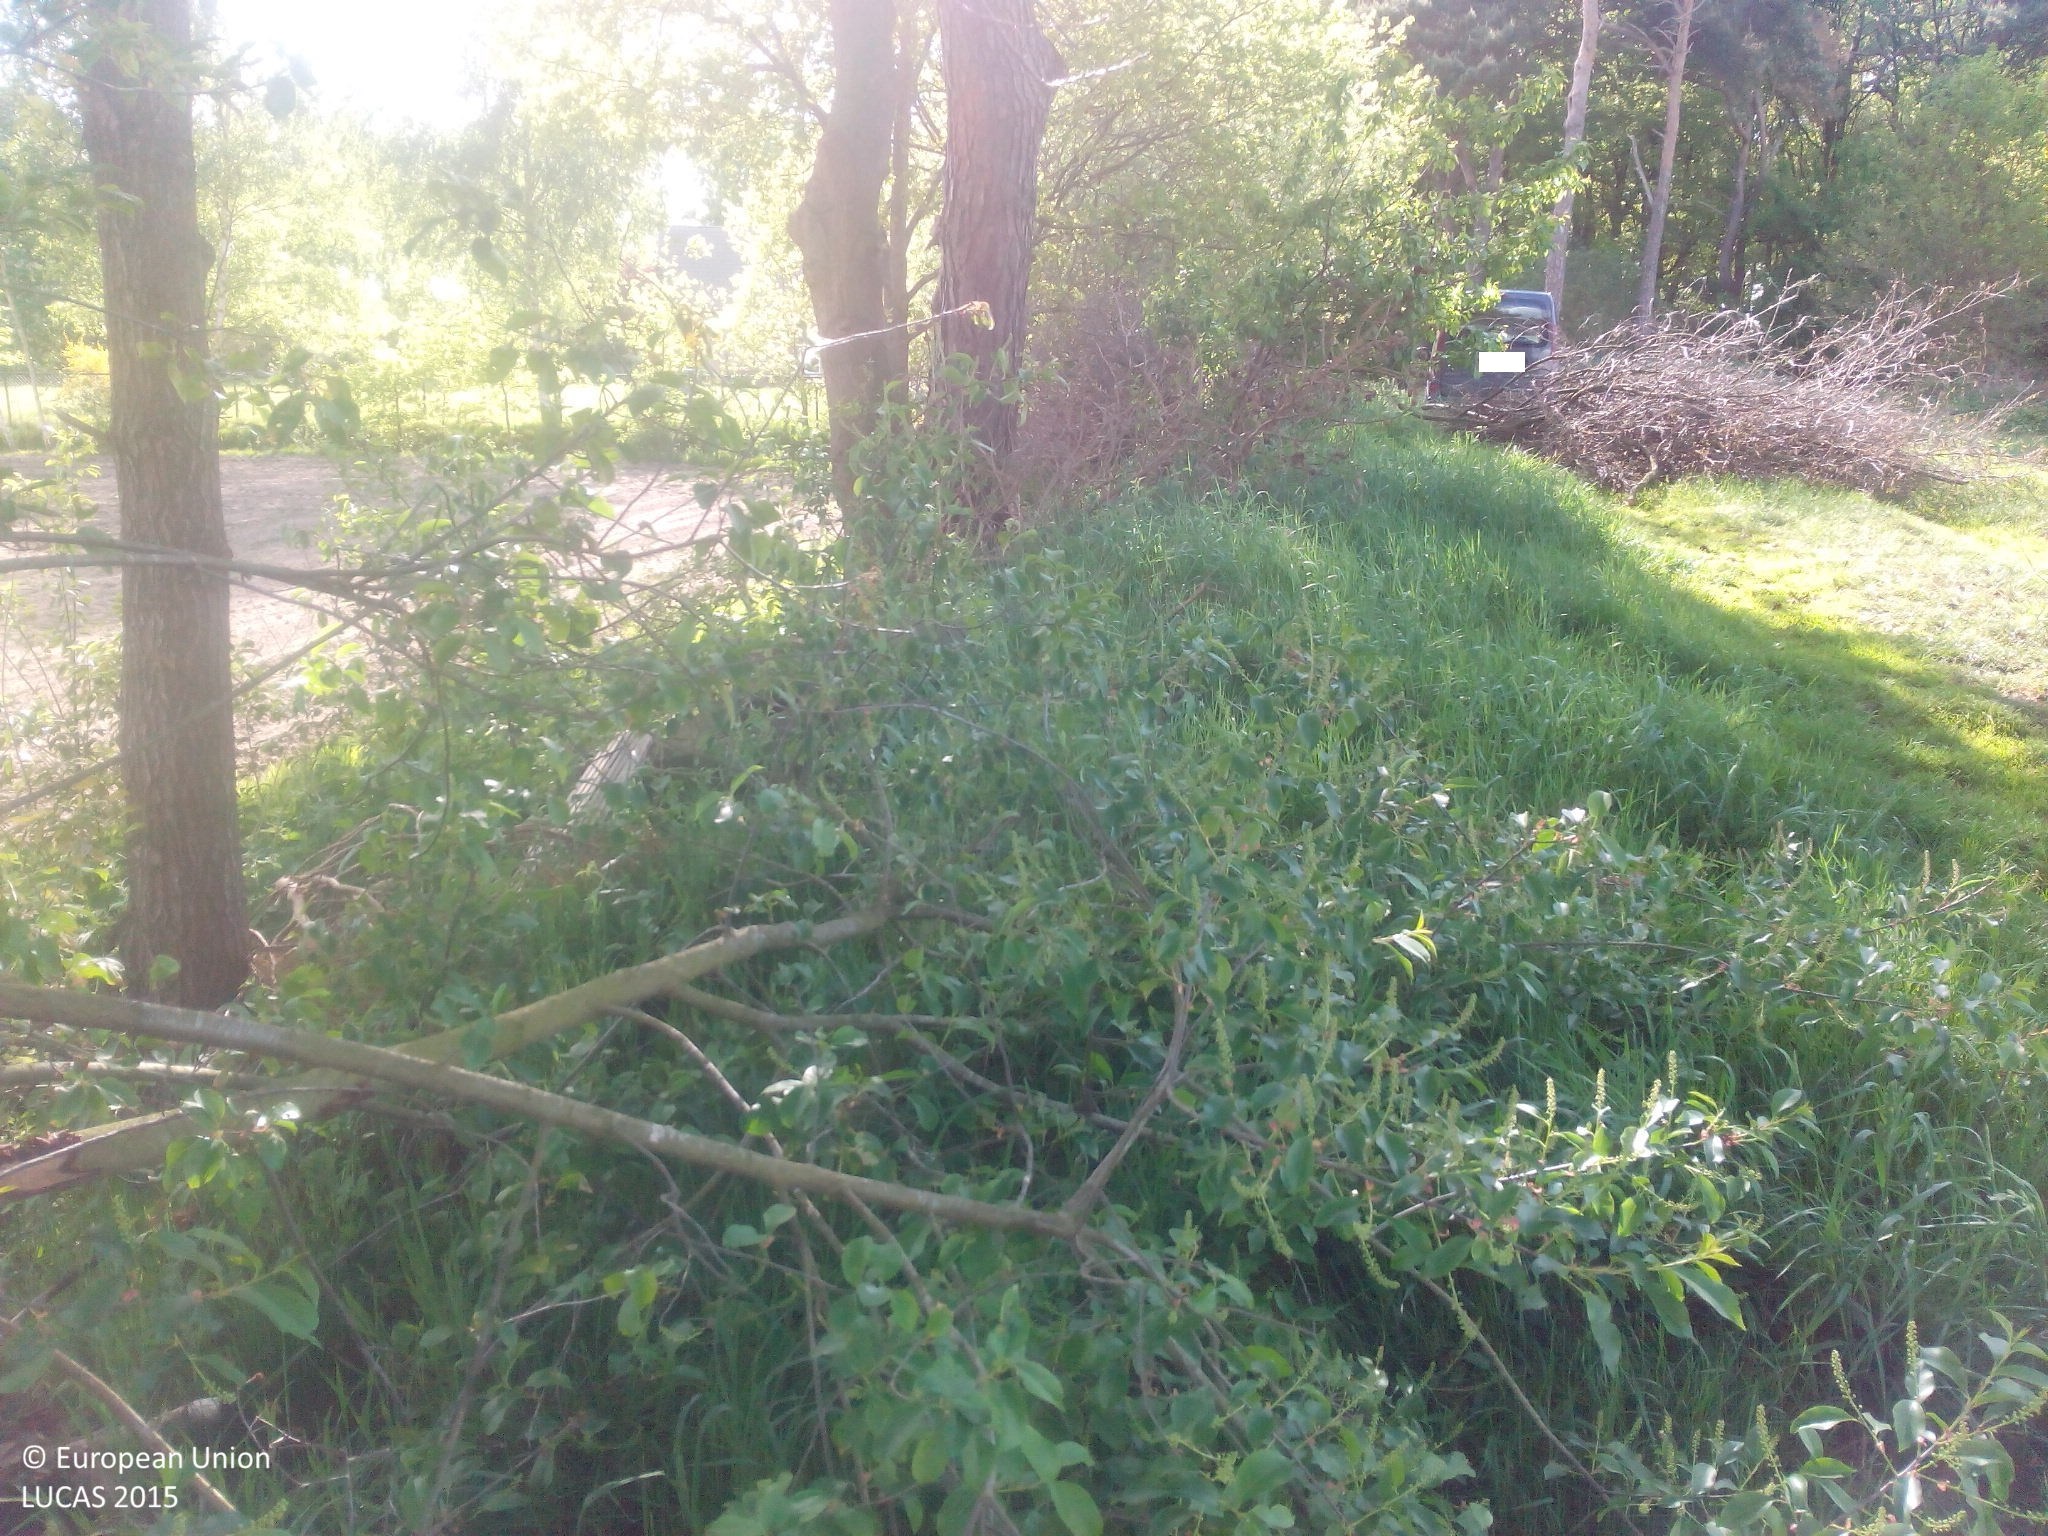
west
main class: Woodland
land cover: Pine dominated mixed woodland
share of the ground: 25 - 50 %
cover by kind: coniferous forest trees 35 %, unconsolidated bare surface 30 %, herbaceous plants 20 %, broadleaved forest trees 15 %
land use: Agriculture (excluding fallow land and kitchen gardens)
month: May
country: NL
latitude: 51.4671
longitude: 5.5790
